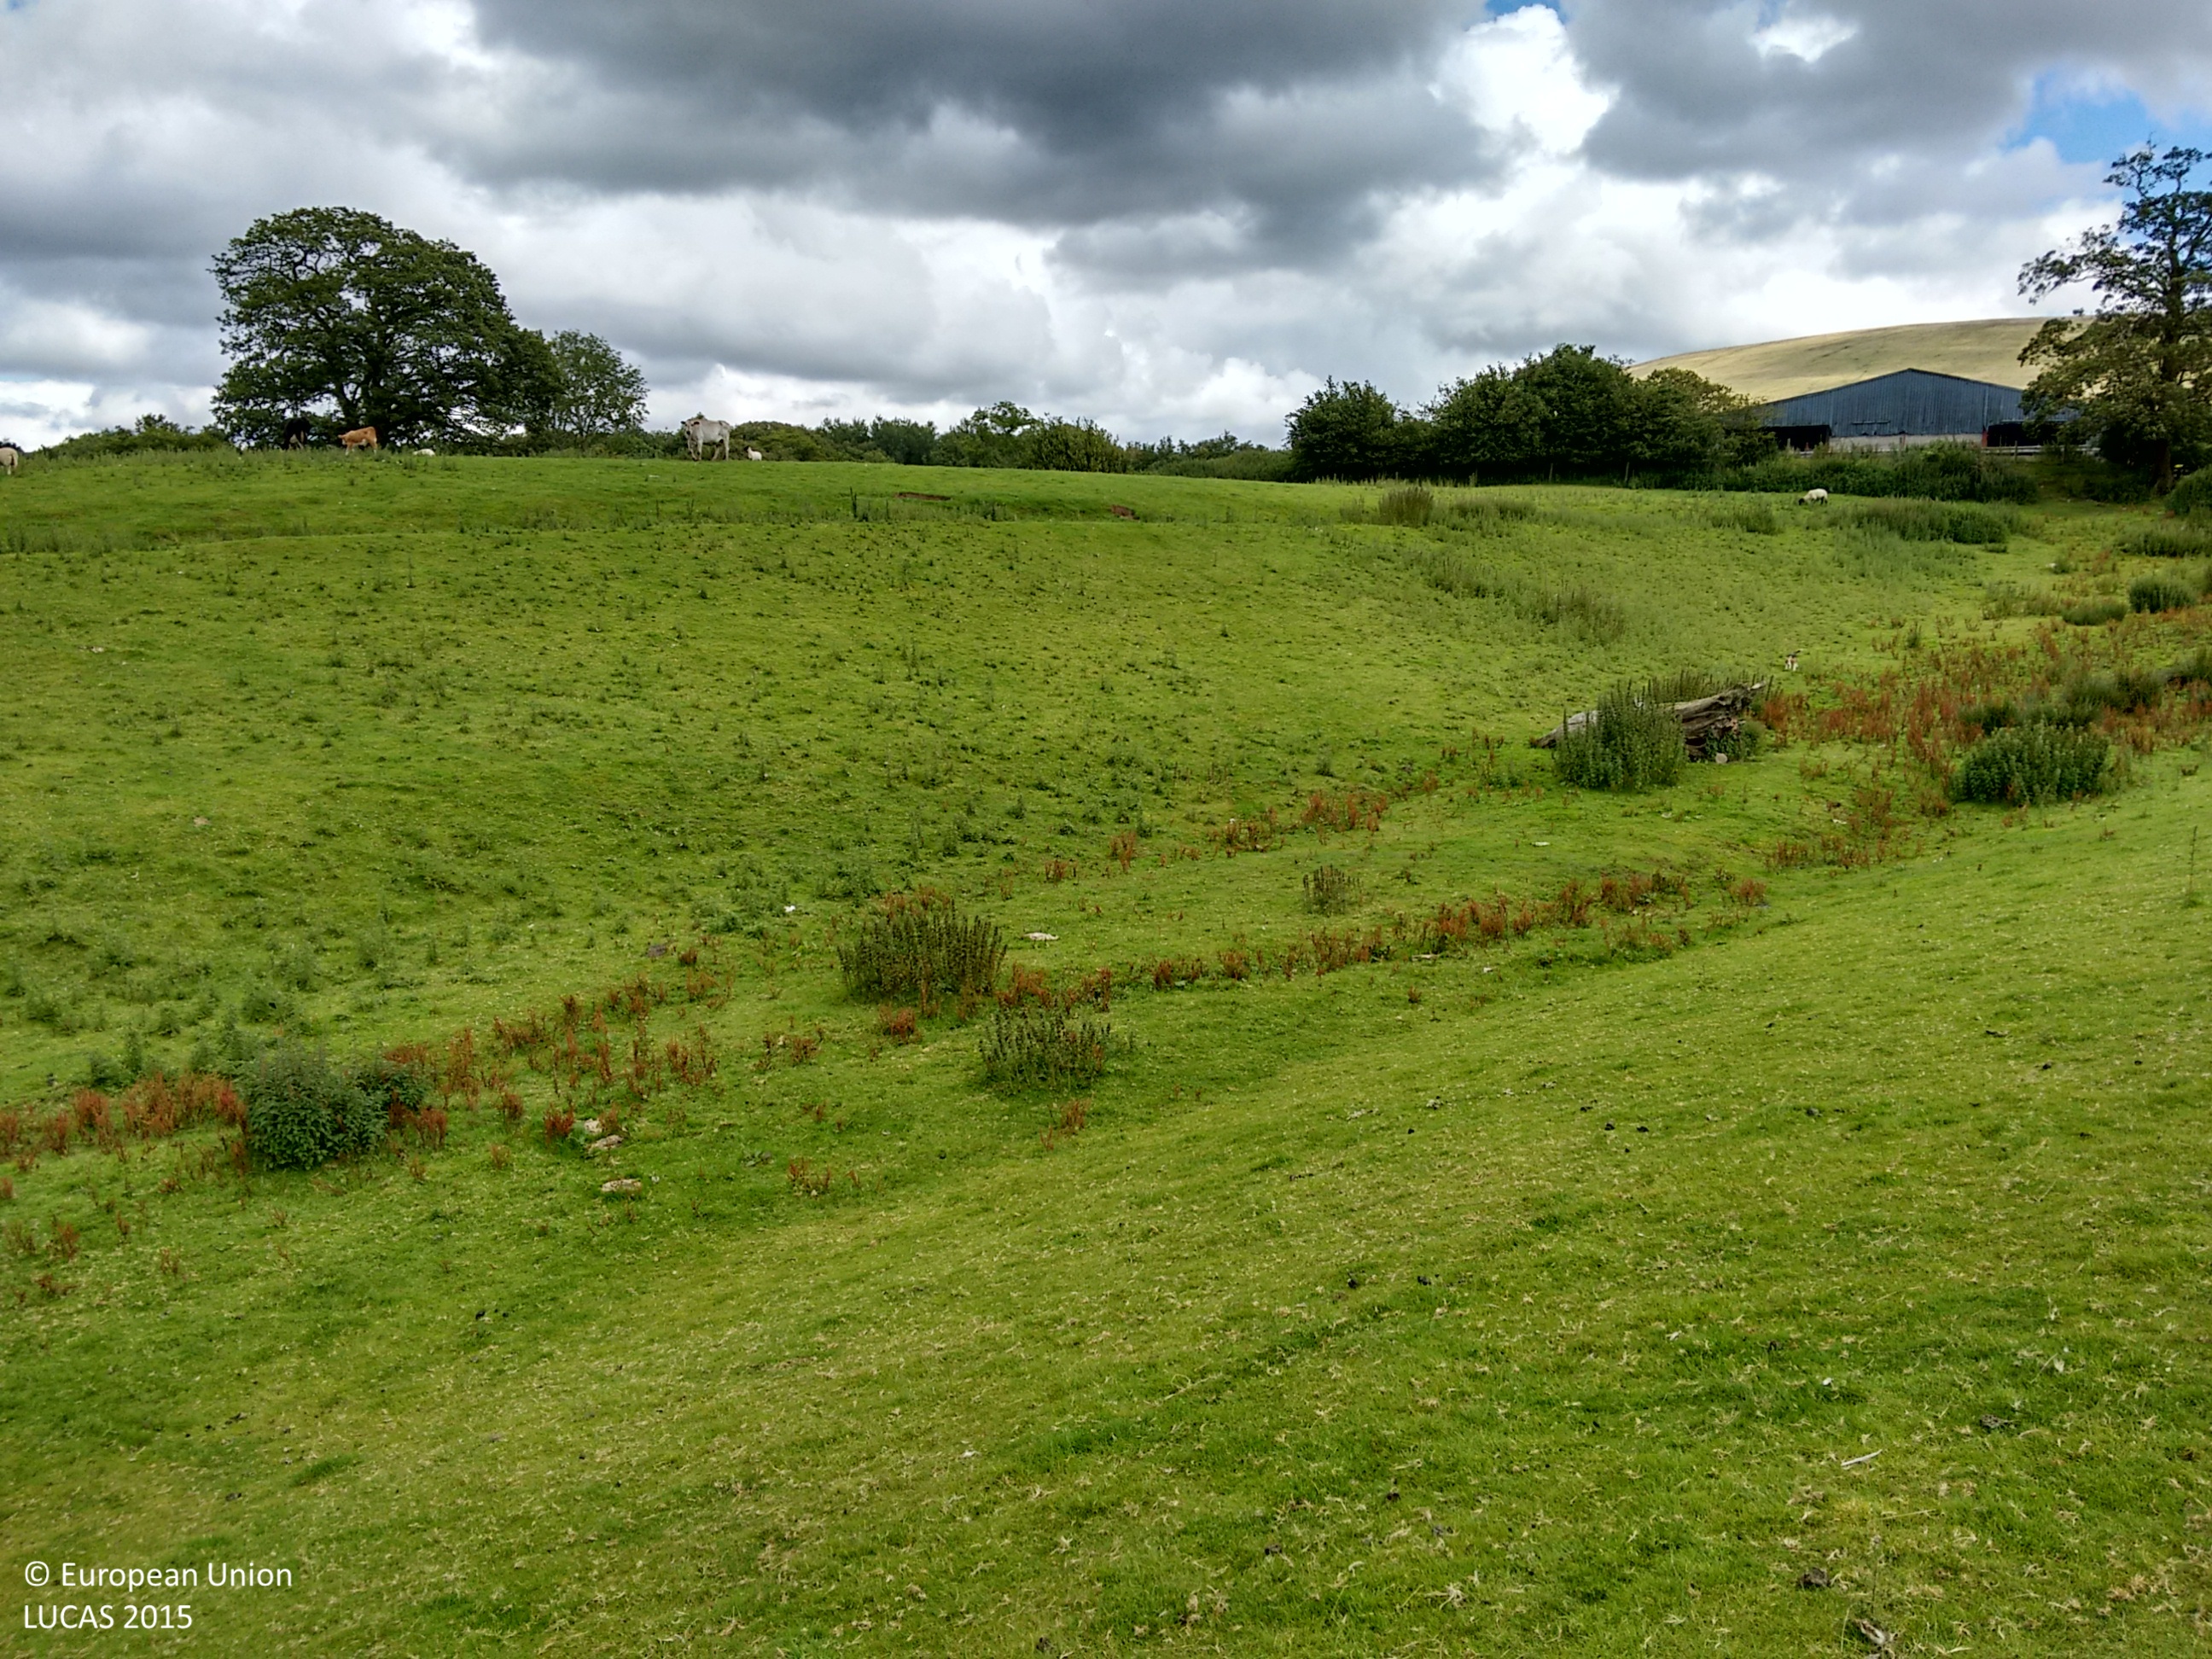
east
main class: Grassland
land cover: Grassland without tree/shrub cover
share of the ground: > 75 %
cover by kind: herbaceous plants 100 %
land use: Agriculture (excluding fallow land and kitchen gardens)
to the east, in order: Grassland without tree/shrub cover; Fences; Lines of trees; Grassland without tree/shrub cover; Managed hedges; Fences; Managed hedges; Grass margins; Paved roads, cycling and walking lanes; Grass margins; Managed hedges; Fences; Managed hedges; Electric lines; Grassland without tree/shrub cover
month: July
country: GB
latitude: 51.8712
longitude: -3.8457
